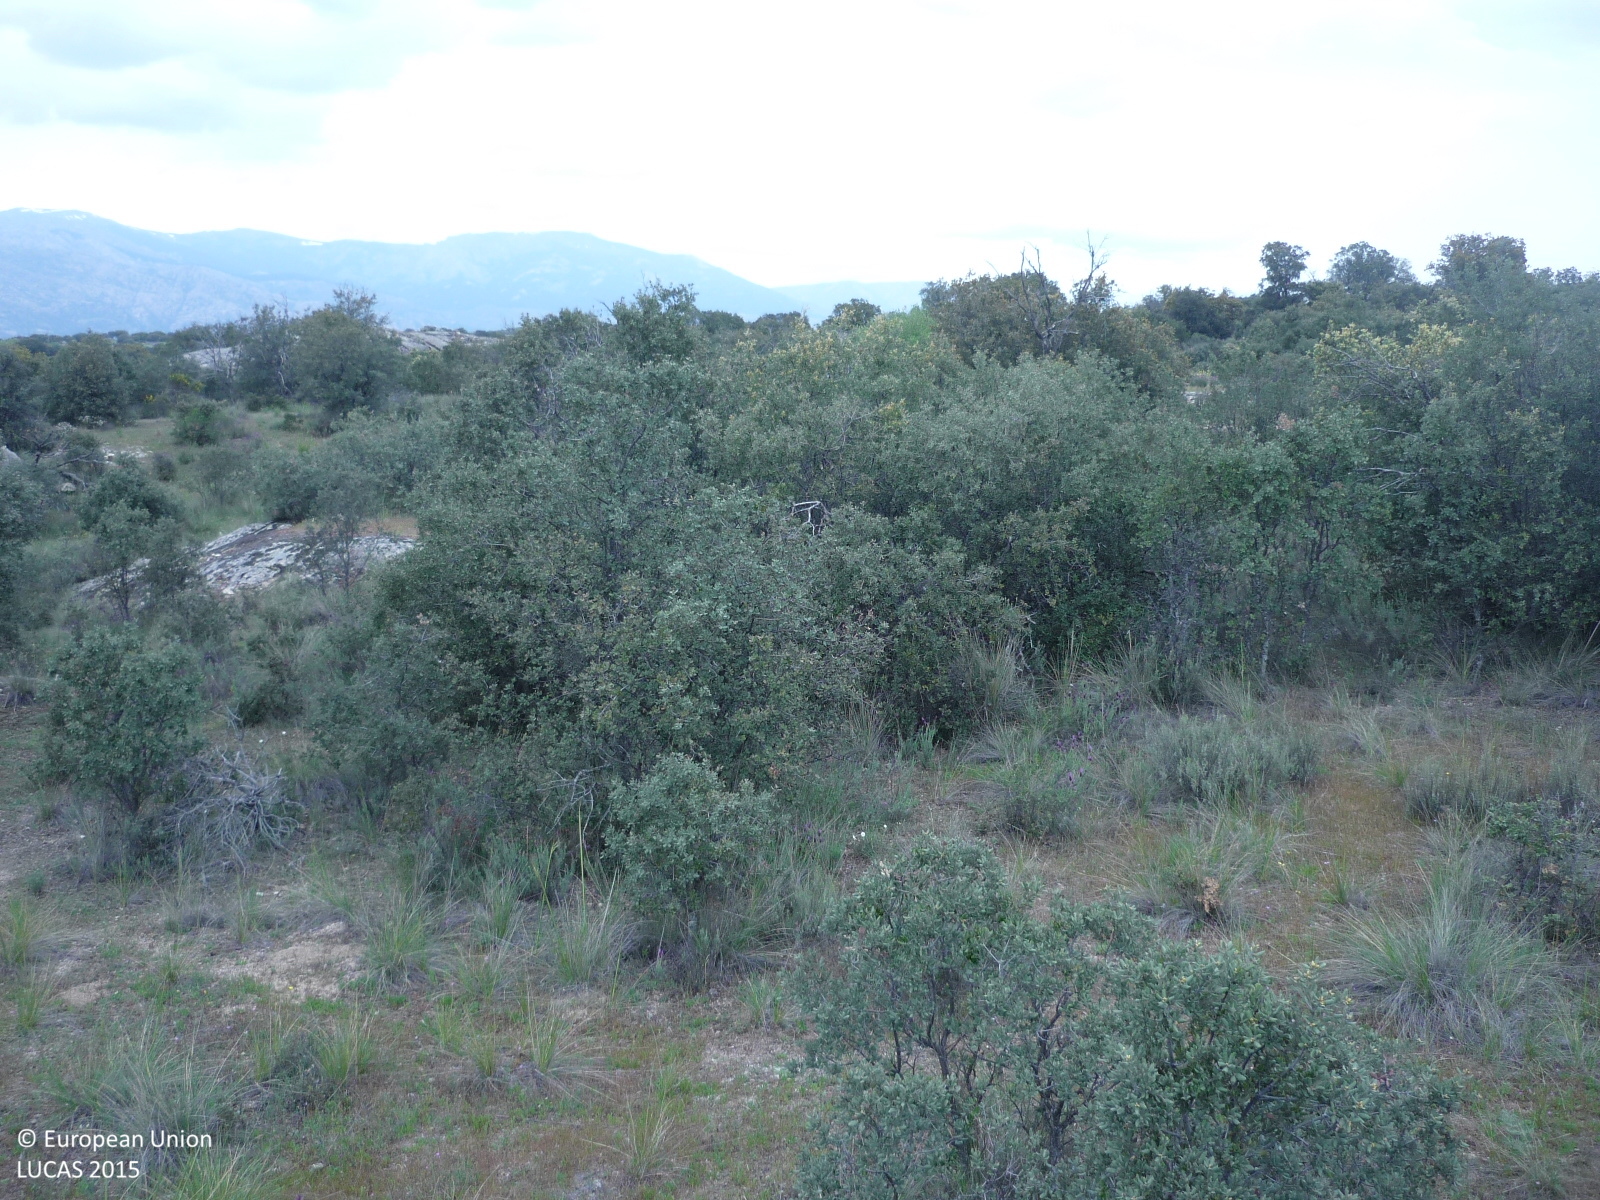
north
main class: Grassland
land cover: Grassland with sparse tree/shrub cover
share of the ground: > 75 %
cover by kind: herbaceous plants 85 %, shrubs 10 %, broadleaved forest trees 5 %
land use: Agriculture (excluding fallow land and kitchen gardens)
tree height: < 5 m
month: April
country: ES
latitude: 40.6790
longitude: -3.8020
